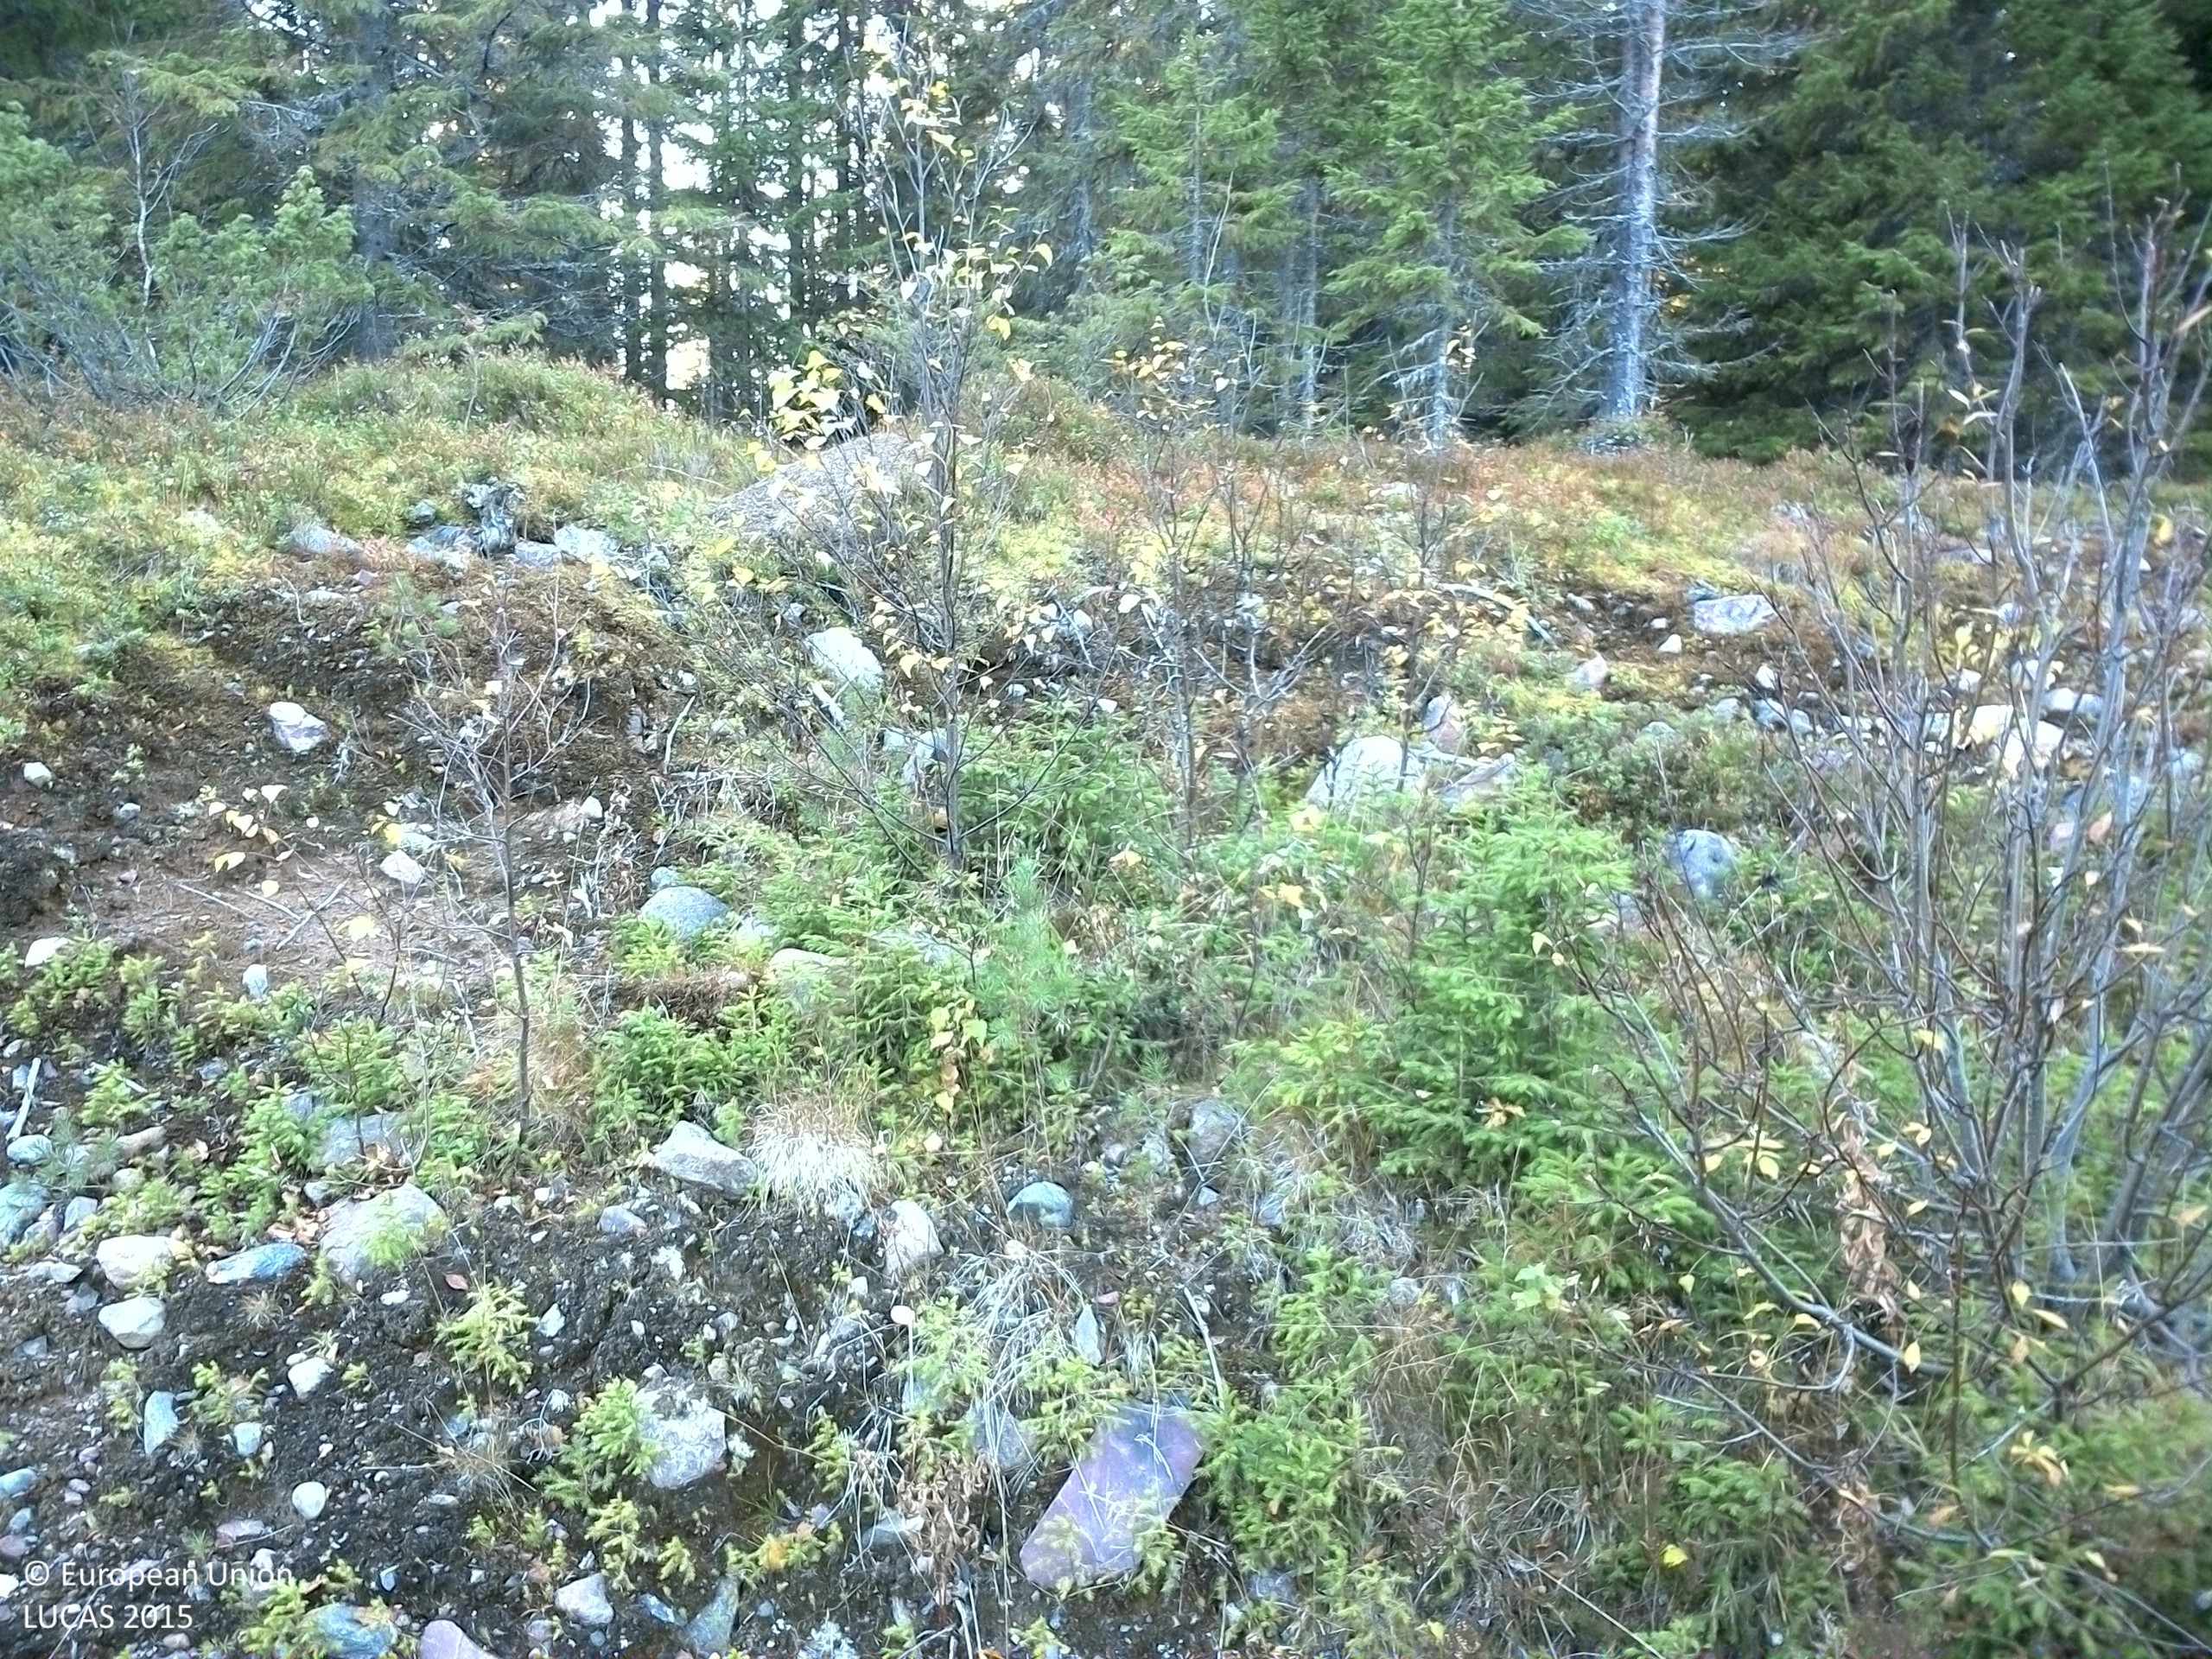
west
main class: Woodland
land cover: Spruce dominated mixed woodland
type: boreal forest
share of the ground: 25 - 50 %
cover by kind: shrubs 30 %, coniferous forest trees 25 %, consolidated bare surface 25 %, broadleaved forest trees 10 %, herbaceous plants 10 %
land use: Road transport
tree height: < 5 m
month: October
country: SE
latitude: 61.2701
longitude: 14.8528
